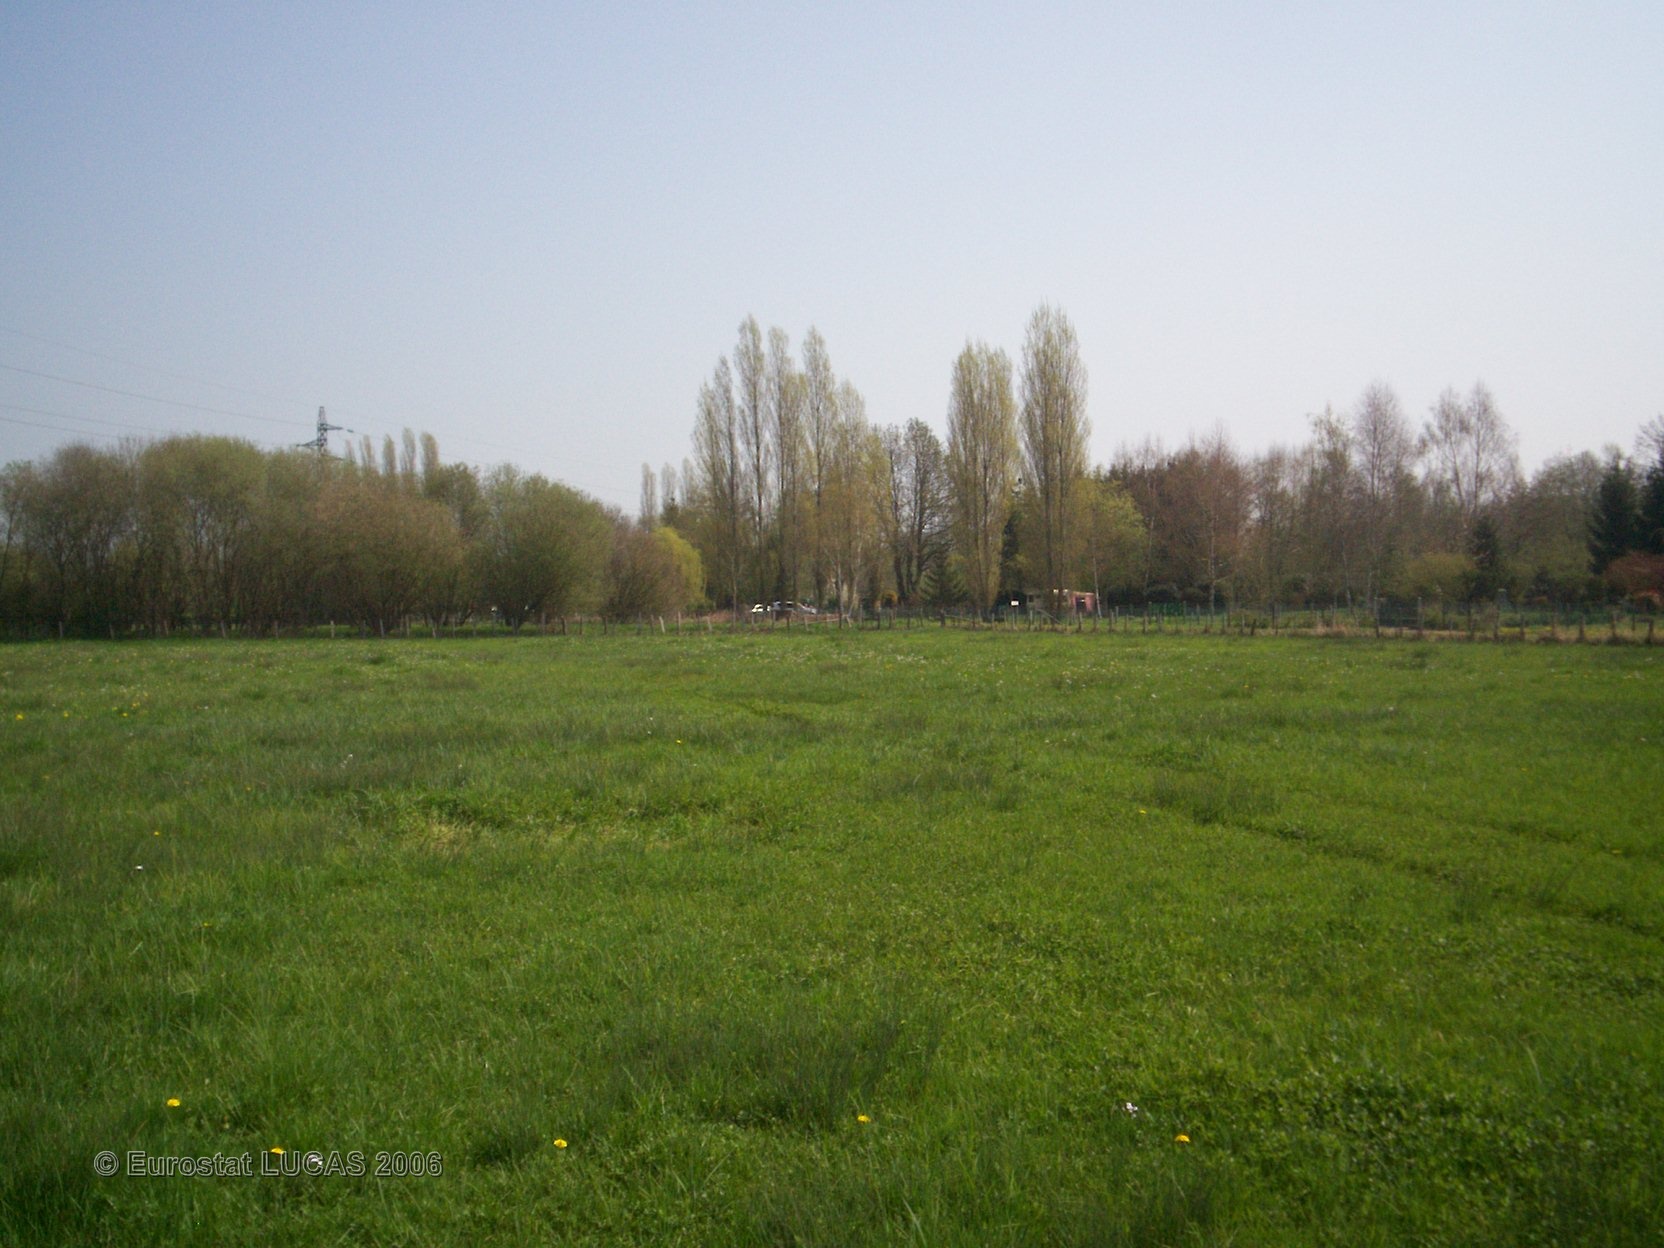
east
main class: Grassland
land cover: Grassland without tree/shrub cover
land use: Agriculture (excluding fallow land and kitchen gardens)
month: April
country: FR
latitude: 48.0380
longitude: 0.3857
